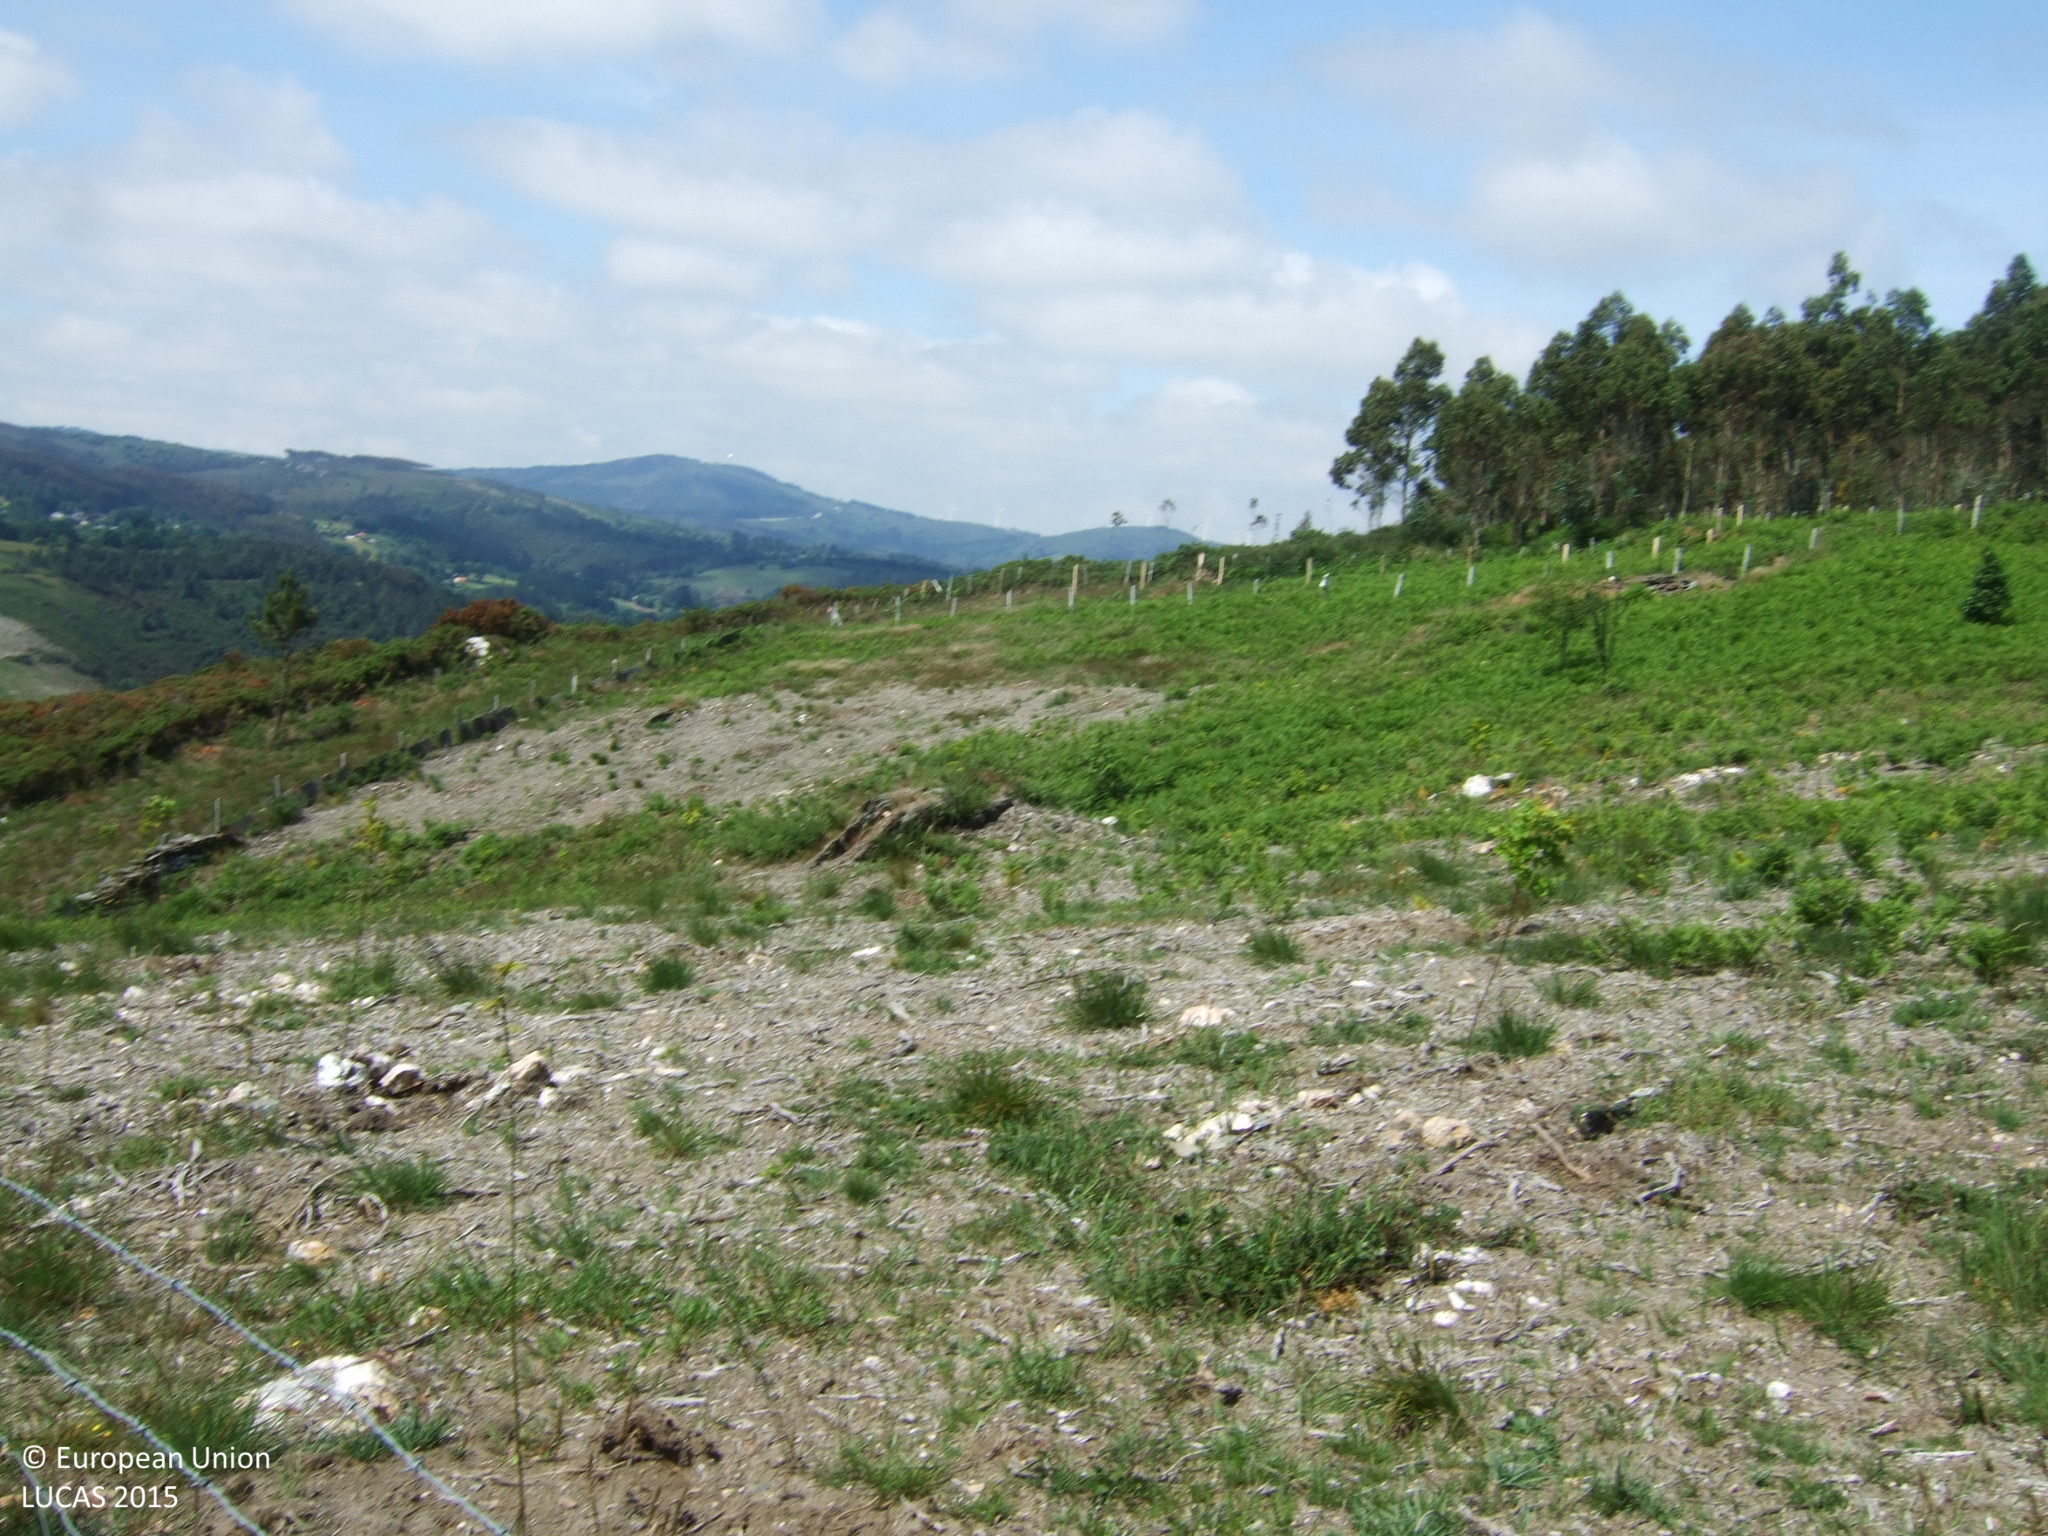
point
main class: Grassland
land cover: Grassland with sparse tree/shrub cover
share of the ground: 50 - 75 %
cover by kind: herbaceous plants 60 %, unconsolidated bare surface 25 %, shrubs 10 %, broadleaved forest trees 5 %
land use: Forestry
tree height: < 5 m
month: June
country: ES
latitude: 43.4557
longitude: -7.8247
